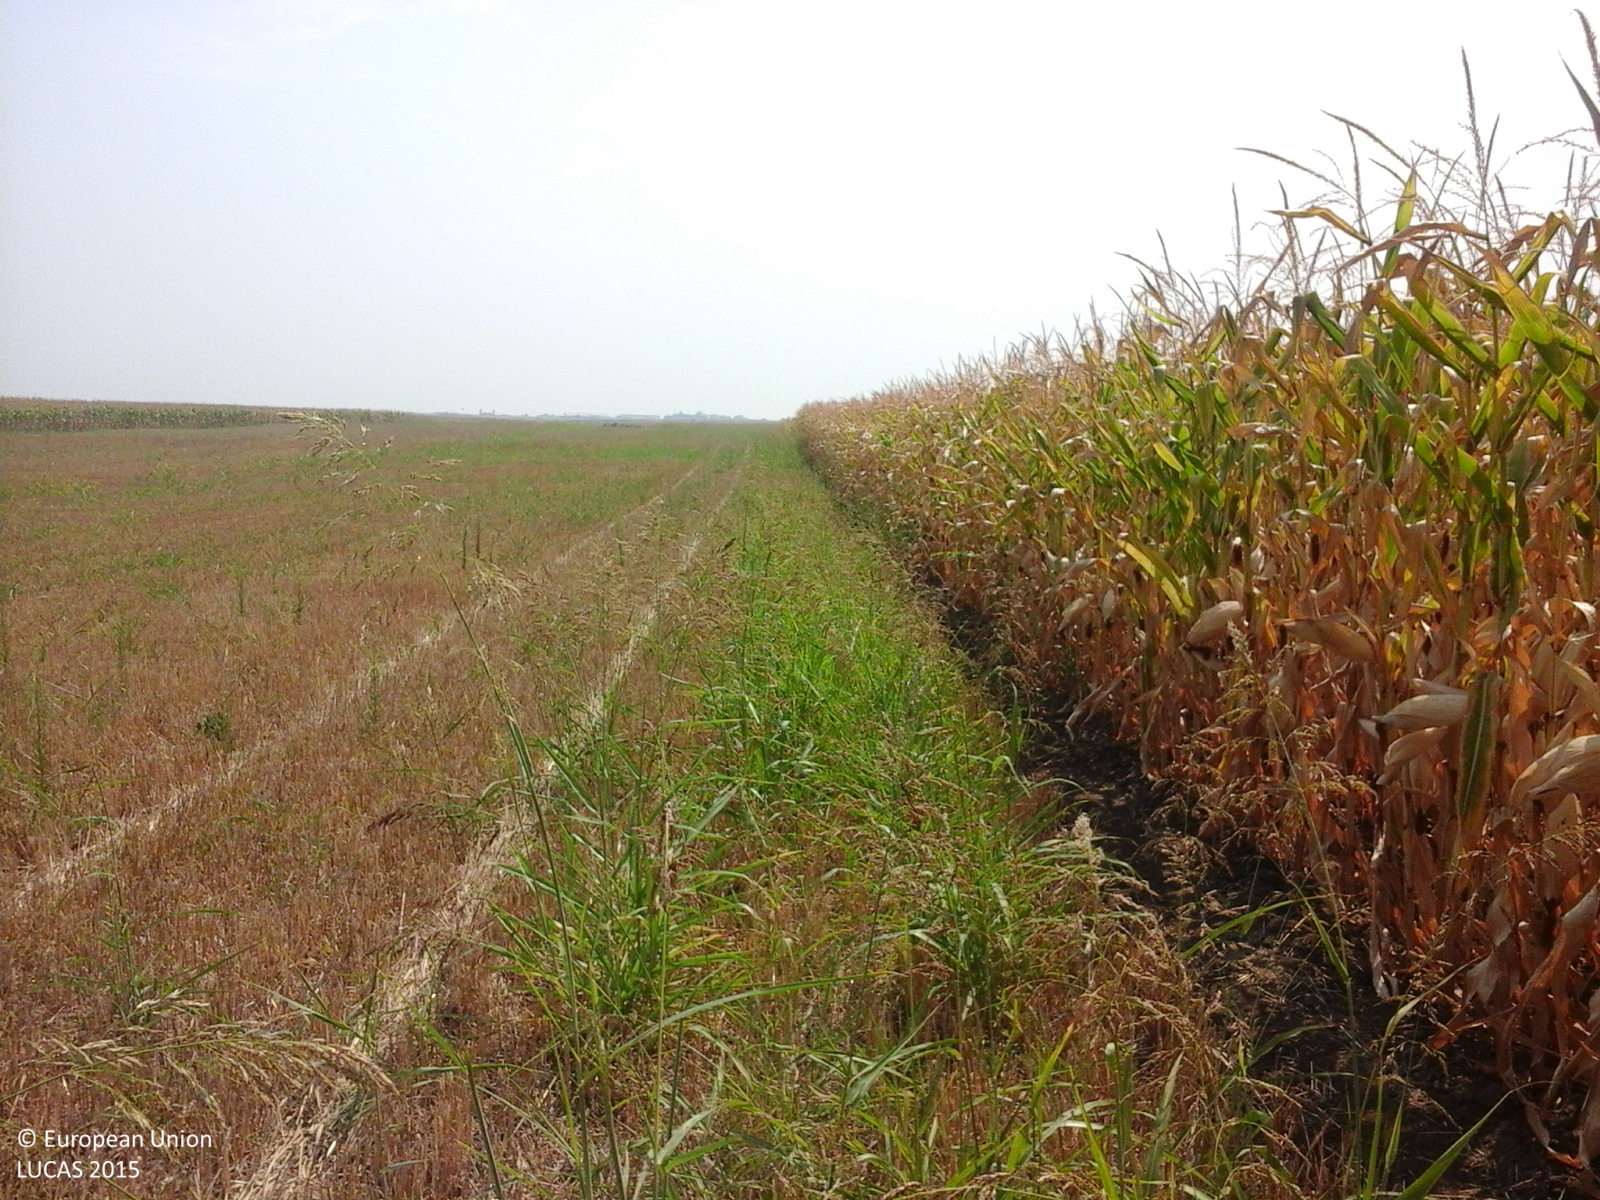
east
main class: Cropland
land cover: Maize
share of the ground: > 75 %
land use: Agriculture (excluding fallow land and kitchen gardens)
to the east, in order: Maize; Spontaneously vegetated surfaces
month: August
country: RO
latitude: 43.8979
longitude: 23.2533
